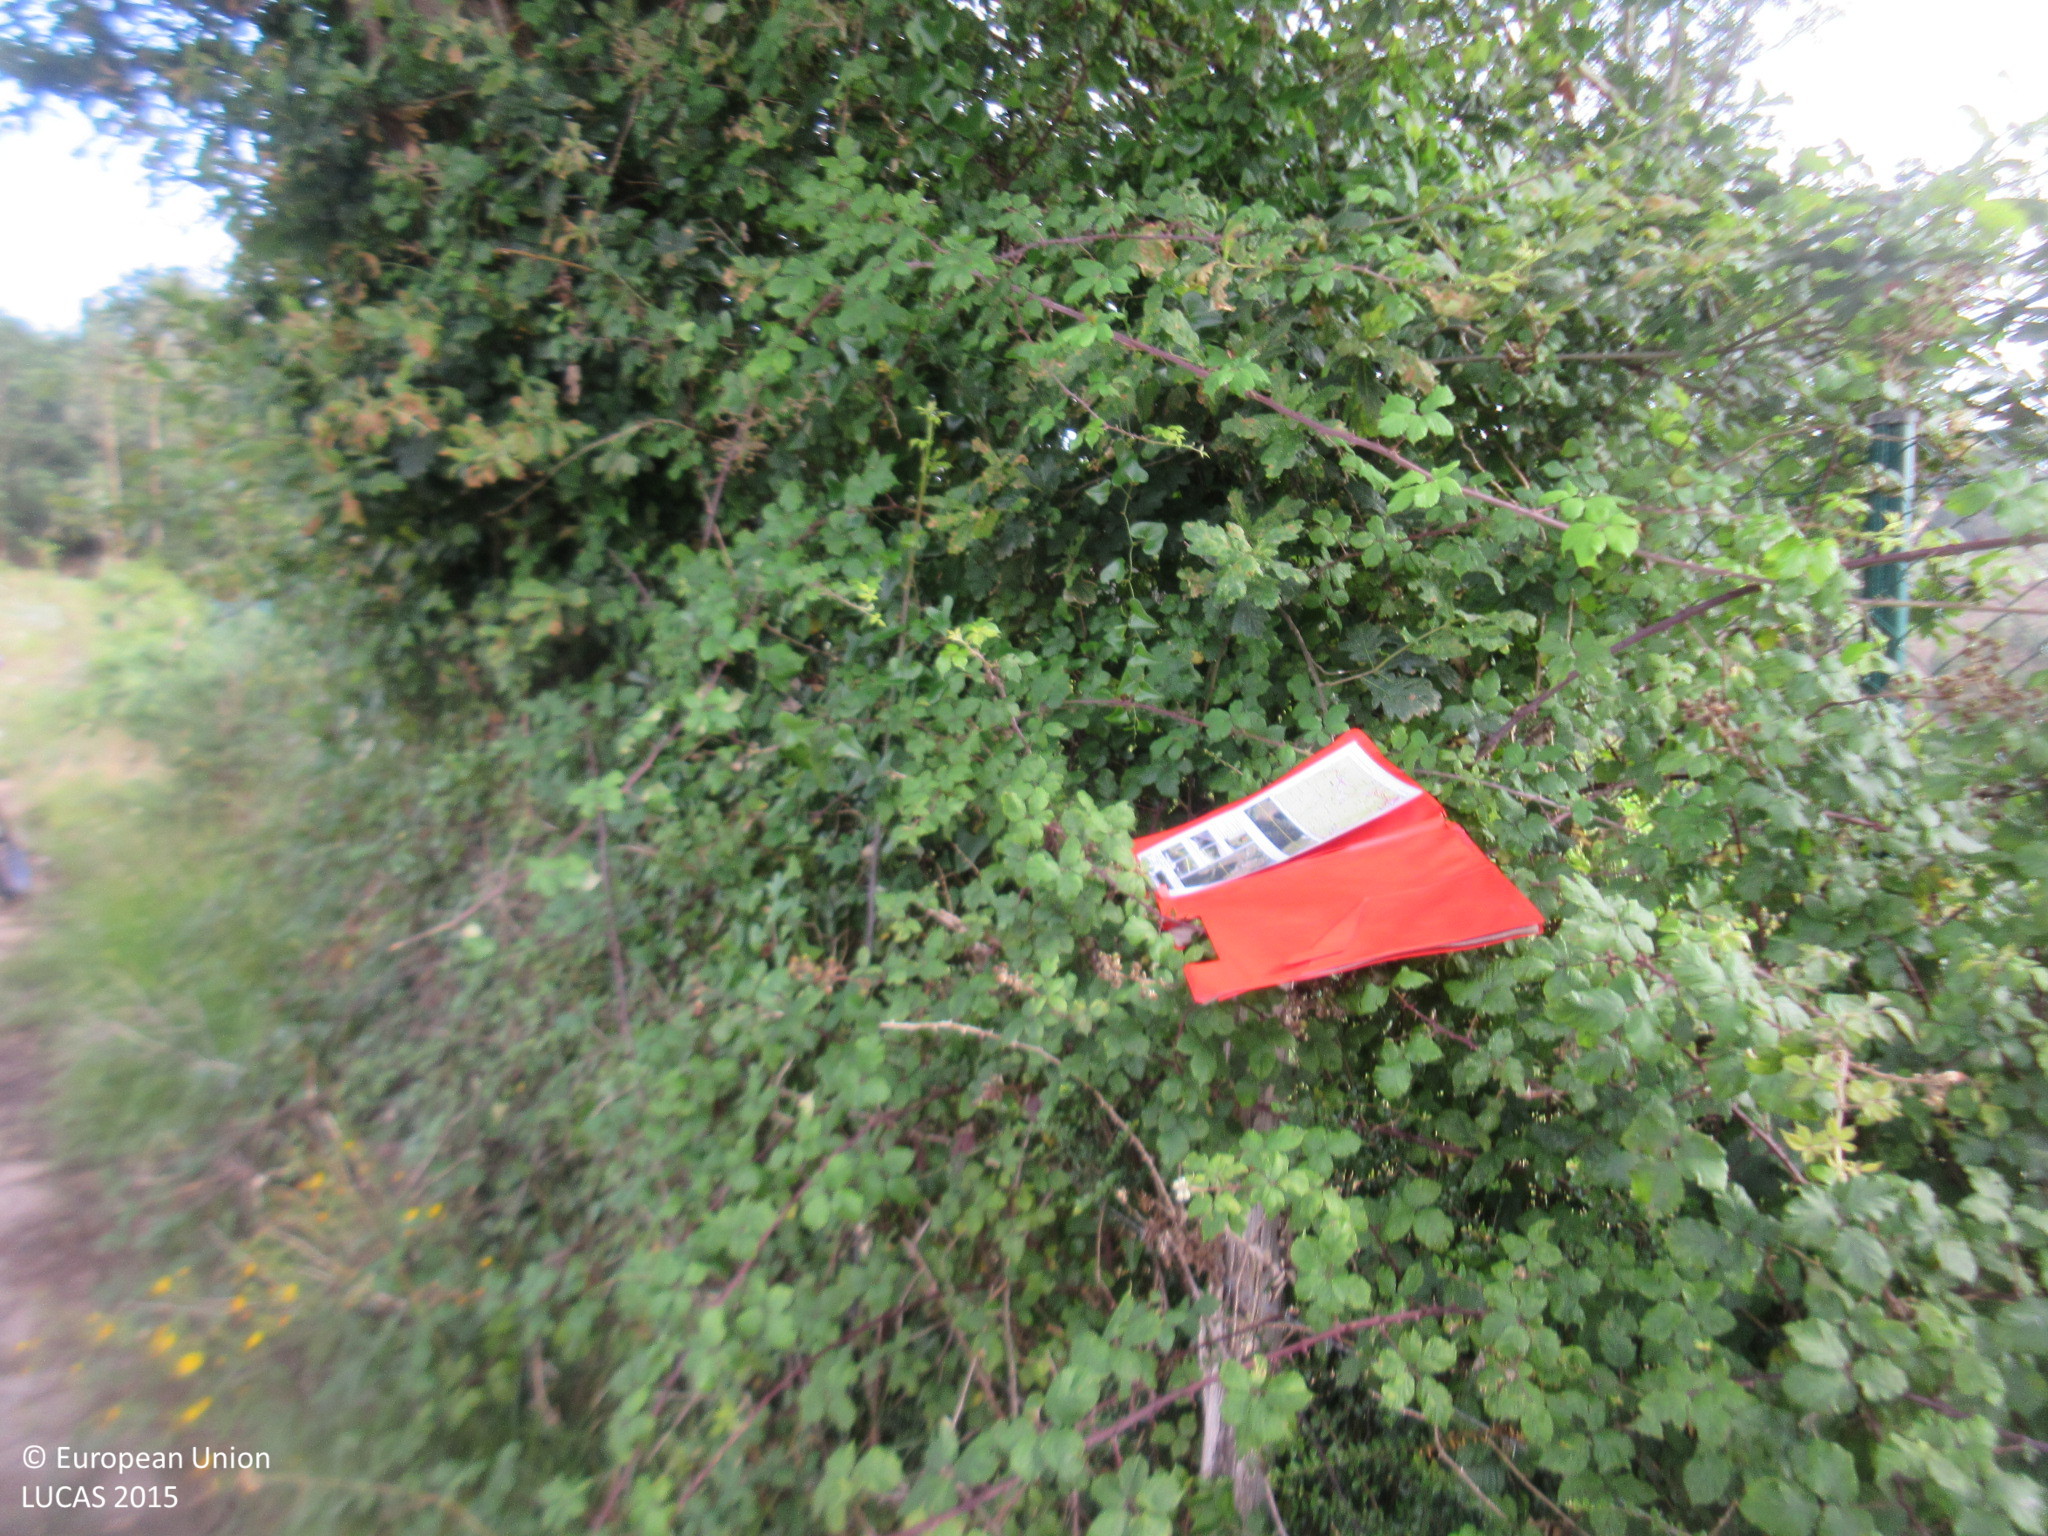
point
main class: Cropland
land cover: Apple fruit
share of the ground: 50 - 75 %
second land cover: Grassland without tree/shrub cover
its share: > 75 %
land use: Agriculture (excluding fallow land and kitchen gardens)
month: July
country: ES
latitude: 43.3619
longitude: -3.9823
